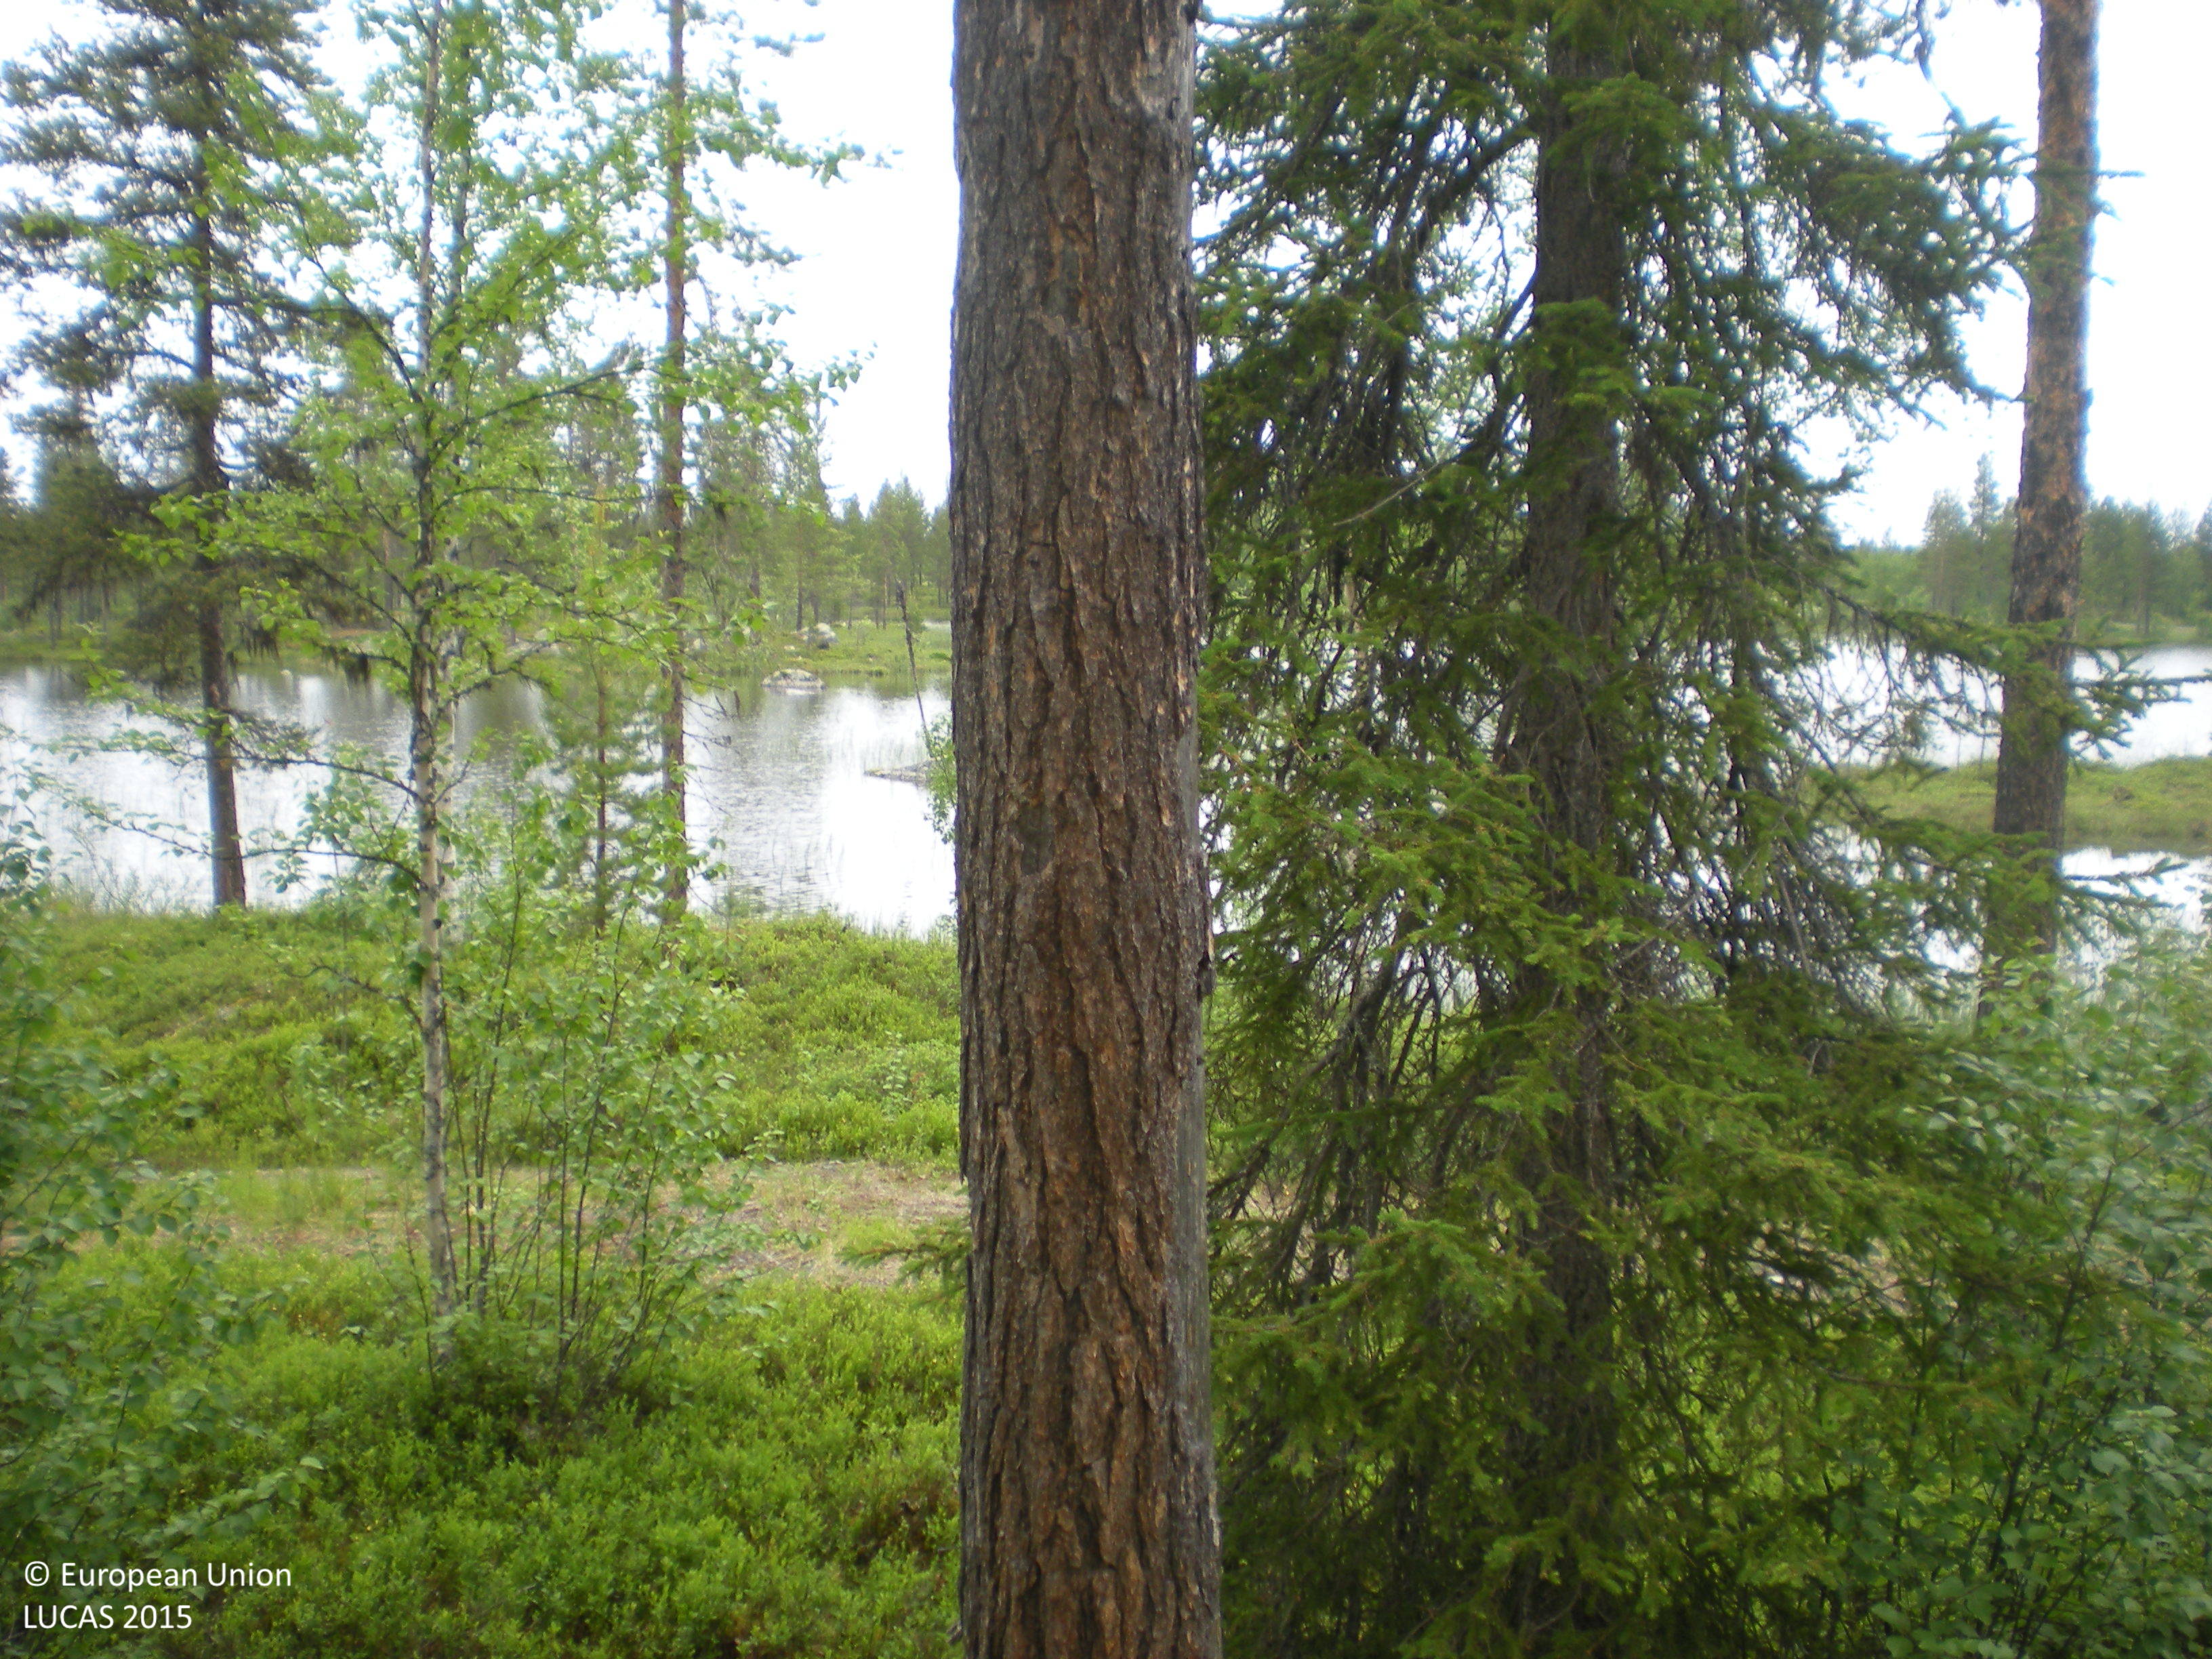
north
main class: Woodland
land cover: Pine dominated mixed woodland
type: boreal forest
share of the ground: 25 - 50 %
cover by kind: coniferous forest trees 30 %, shrubs 30 %, broadleaved forest trees 15 %, consolidated bare surface 15 %, lichens and mosses 10 %
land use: Forestry
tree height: > 5 m
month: July
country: SE
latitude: 65.5306
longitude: 17.0353
